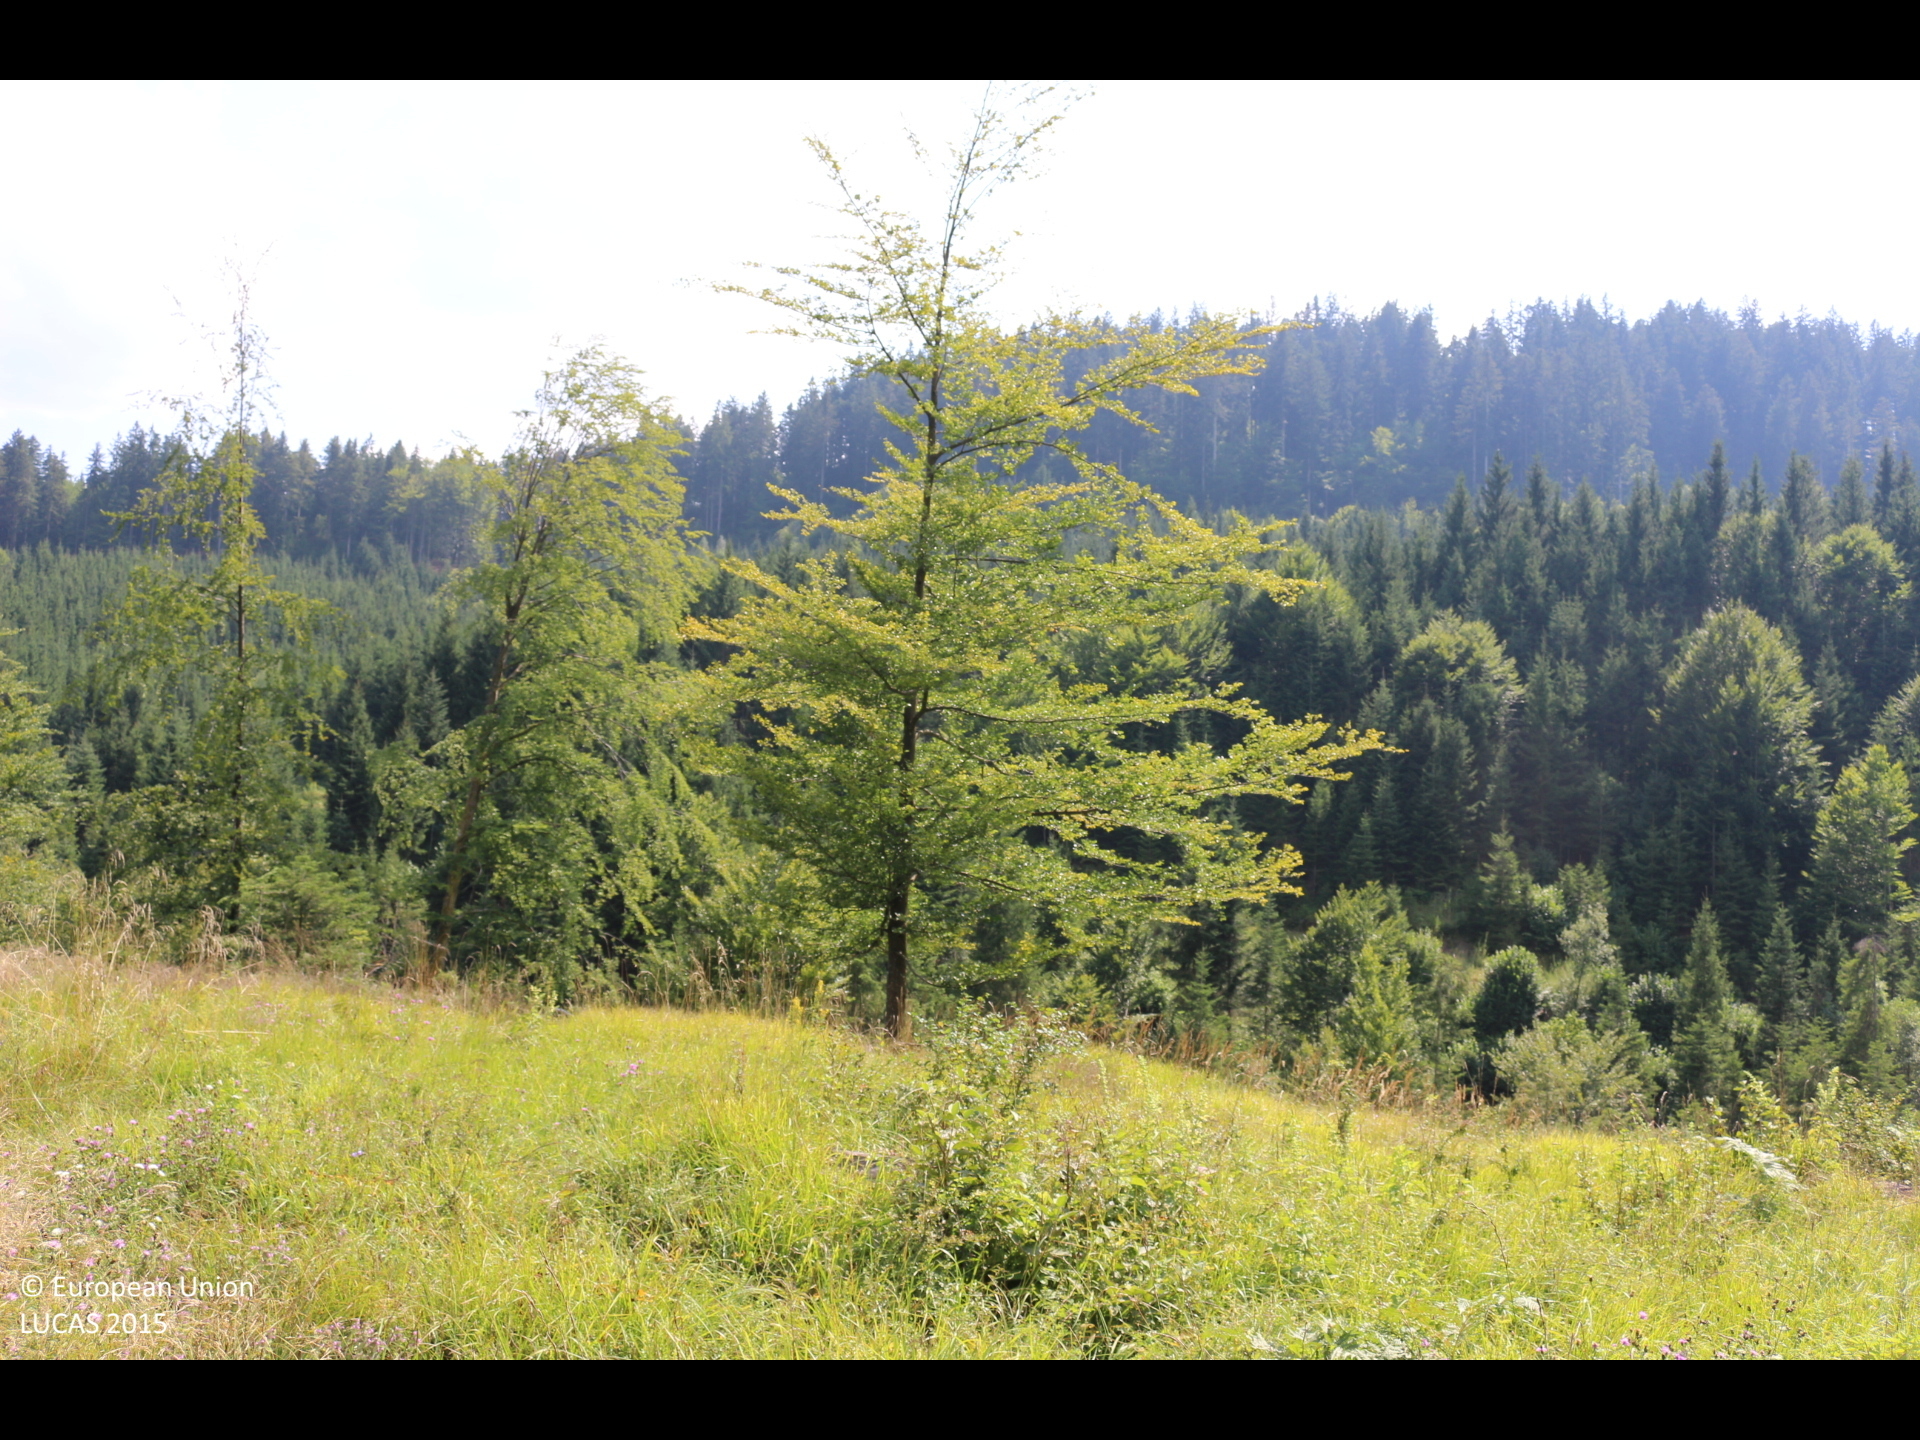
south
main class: Grassland
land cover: Grassland without tree/shrub cover
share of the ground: > 75 %
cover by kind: herbaceous plants 95 %, shrubs 5 %
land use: Forestry
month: August
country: AT
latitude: 46.6403
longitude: 13.3807
